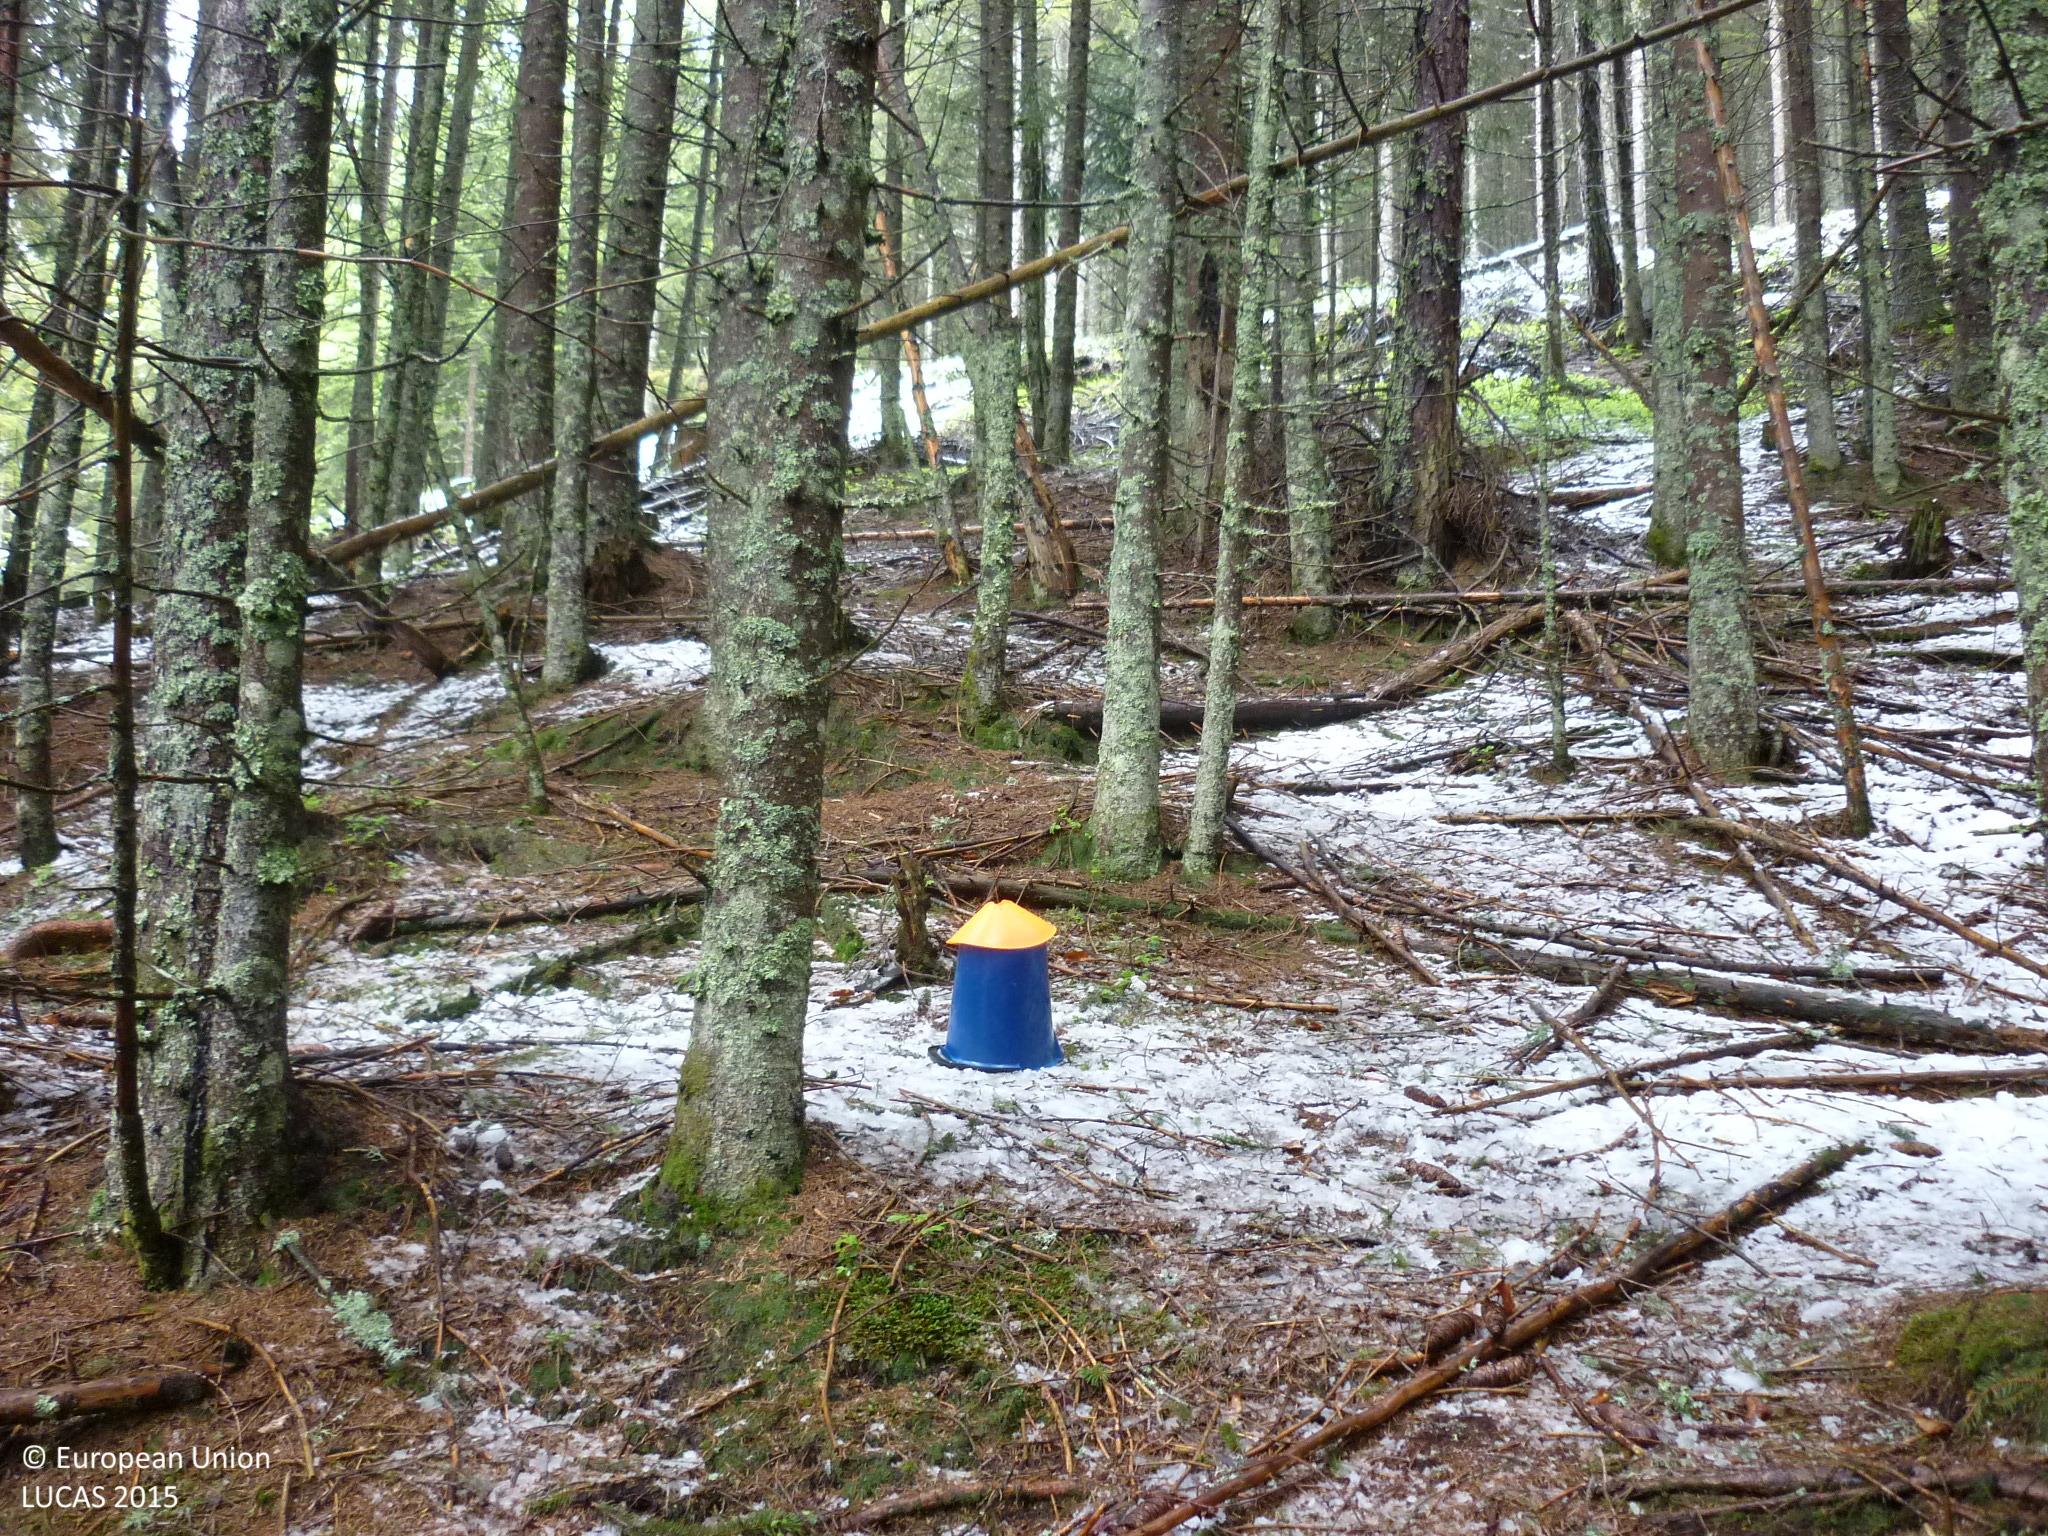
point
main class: Woodland
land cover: Spruce dominated coniferous woodland
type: alpine coniferous forest
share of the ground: > 75 %
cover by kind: coniferous forest trees 95 %, lichens and mosses 5 %
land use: Forestry
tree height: > 5 m
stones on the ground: < 10 %
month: May
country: AT
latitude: 47.4268
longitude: 14.5462
